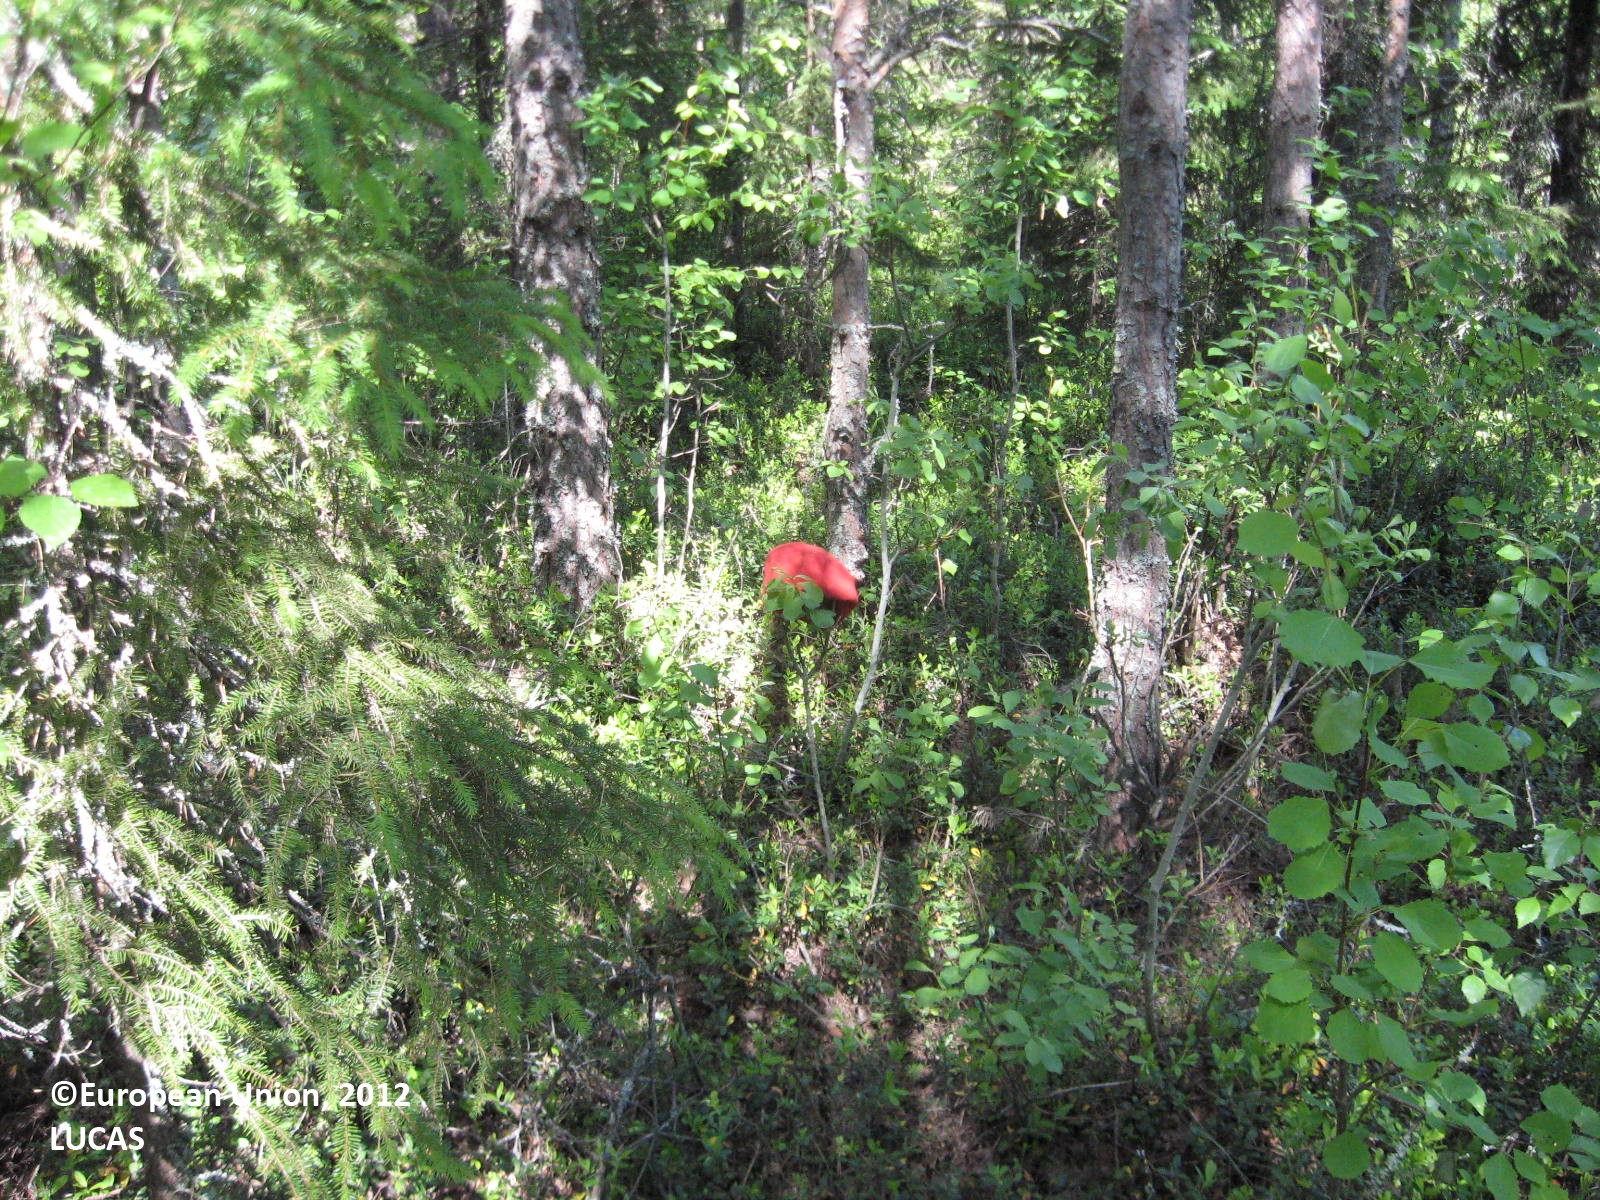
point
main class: Woodland
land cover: Pine dominated mixed woodland
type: boreal forest
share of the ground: > 75 %
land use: Forestry
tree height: > 5 m
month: June
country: FI
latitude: 62.6987
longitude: 21.5135
